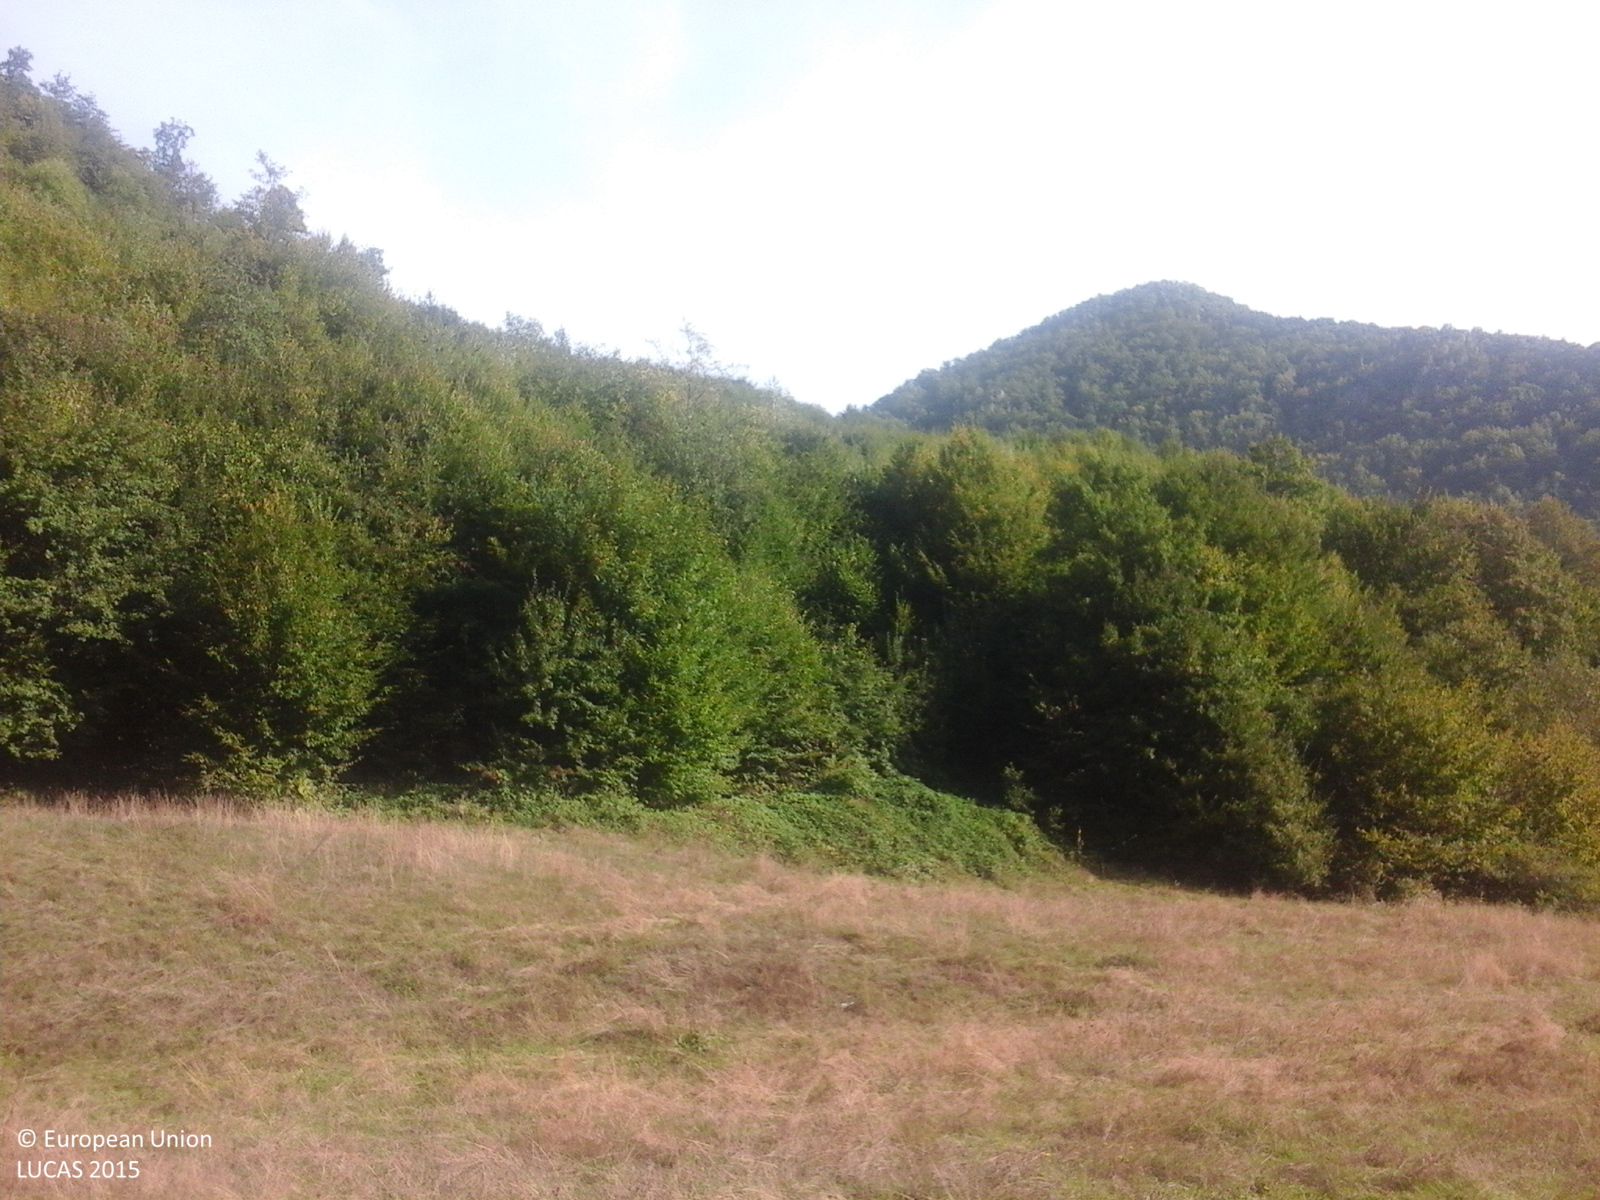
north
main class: Grassland
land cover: Grassland without tree/shrub cover
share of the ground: > 75 %
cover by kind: herbaceous plants 100 %
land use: Agriculture (excluding fallow land and kitchen gardens)
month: September
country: RO
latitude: 46.6858
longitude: 23.2838
